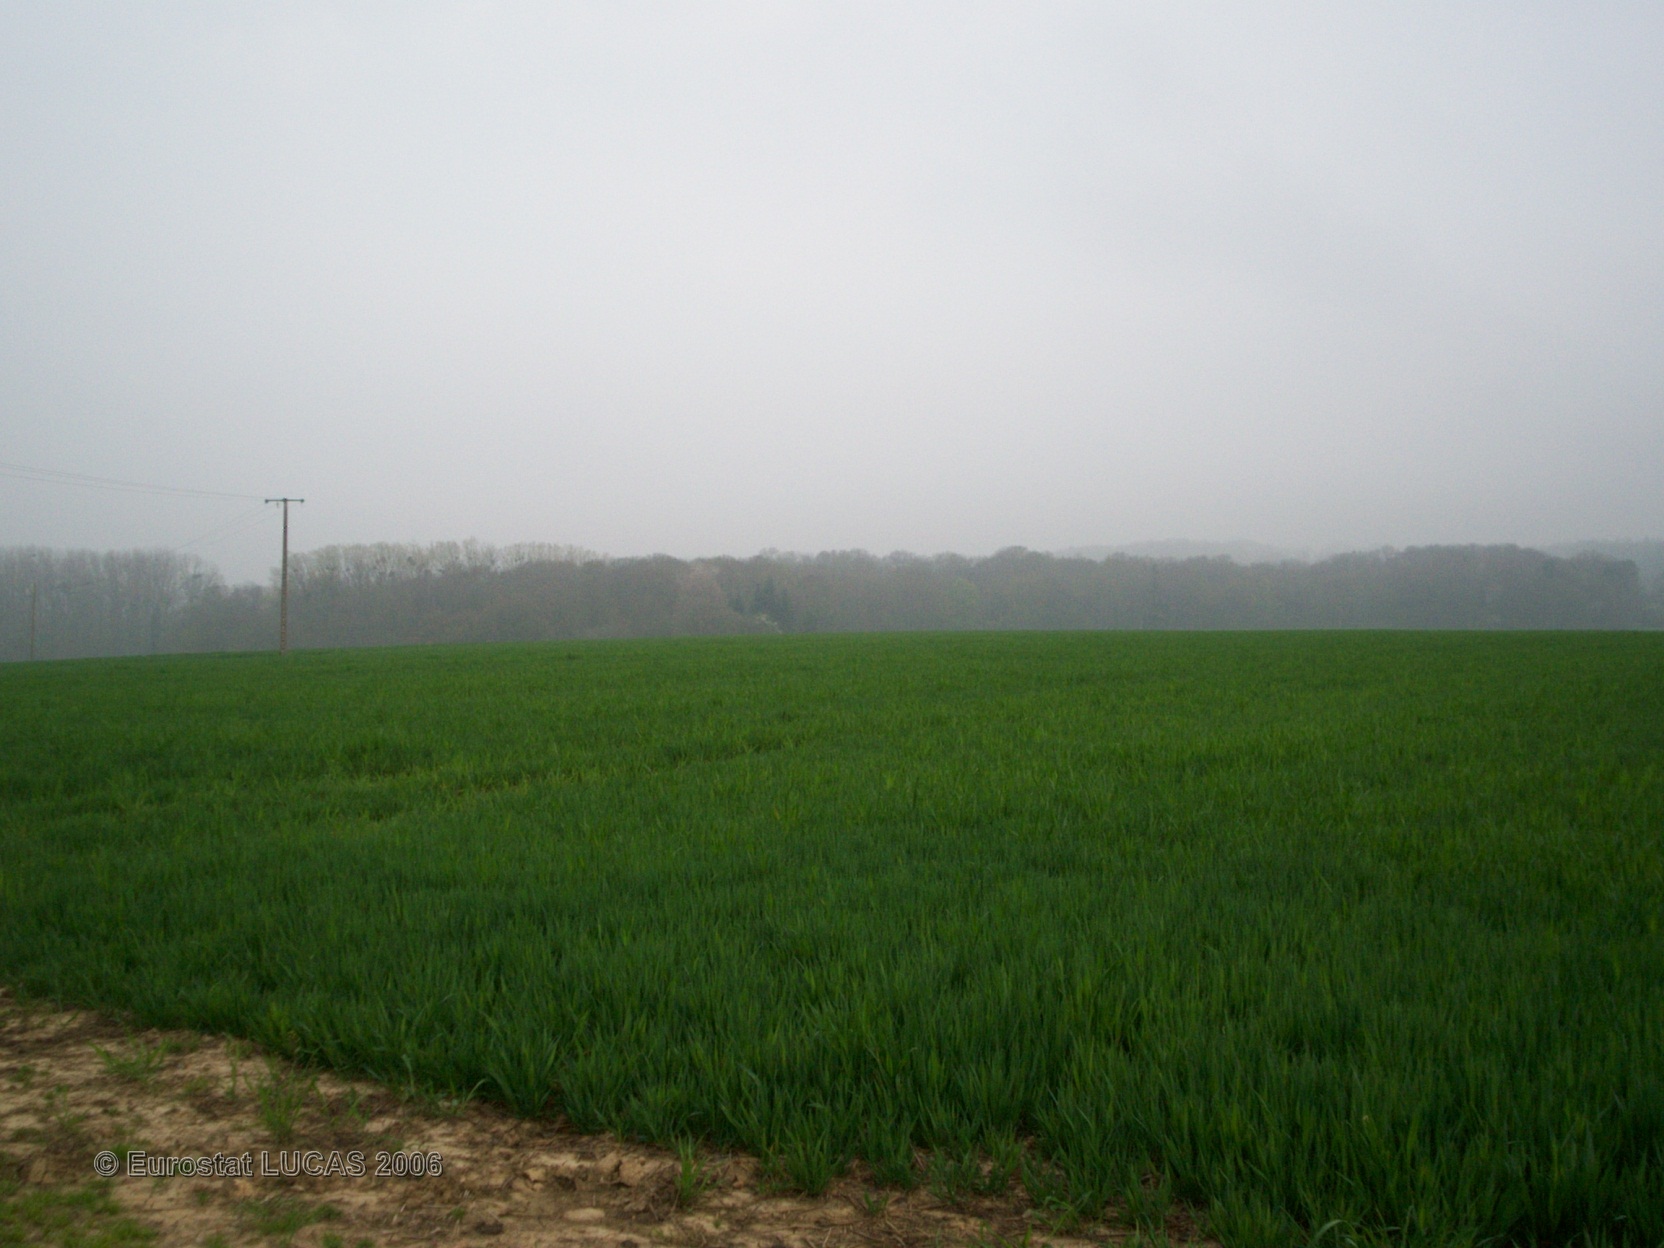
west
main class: Cropland
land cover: Clovers
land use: Agriculture (excluding fallow land and kitchen gardens)
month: May
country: FR
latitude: 48.6794
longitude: 0.2616
